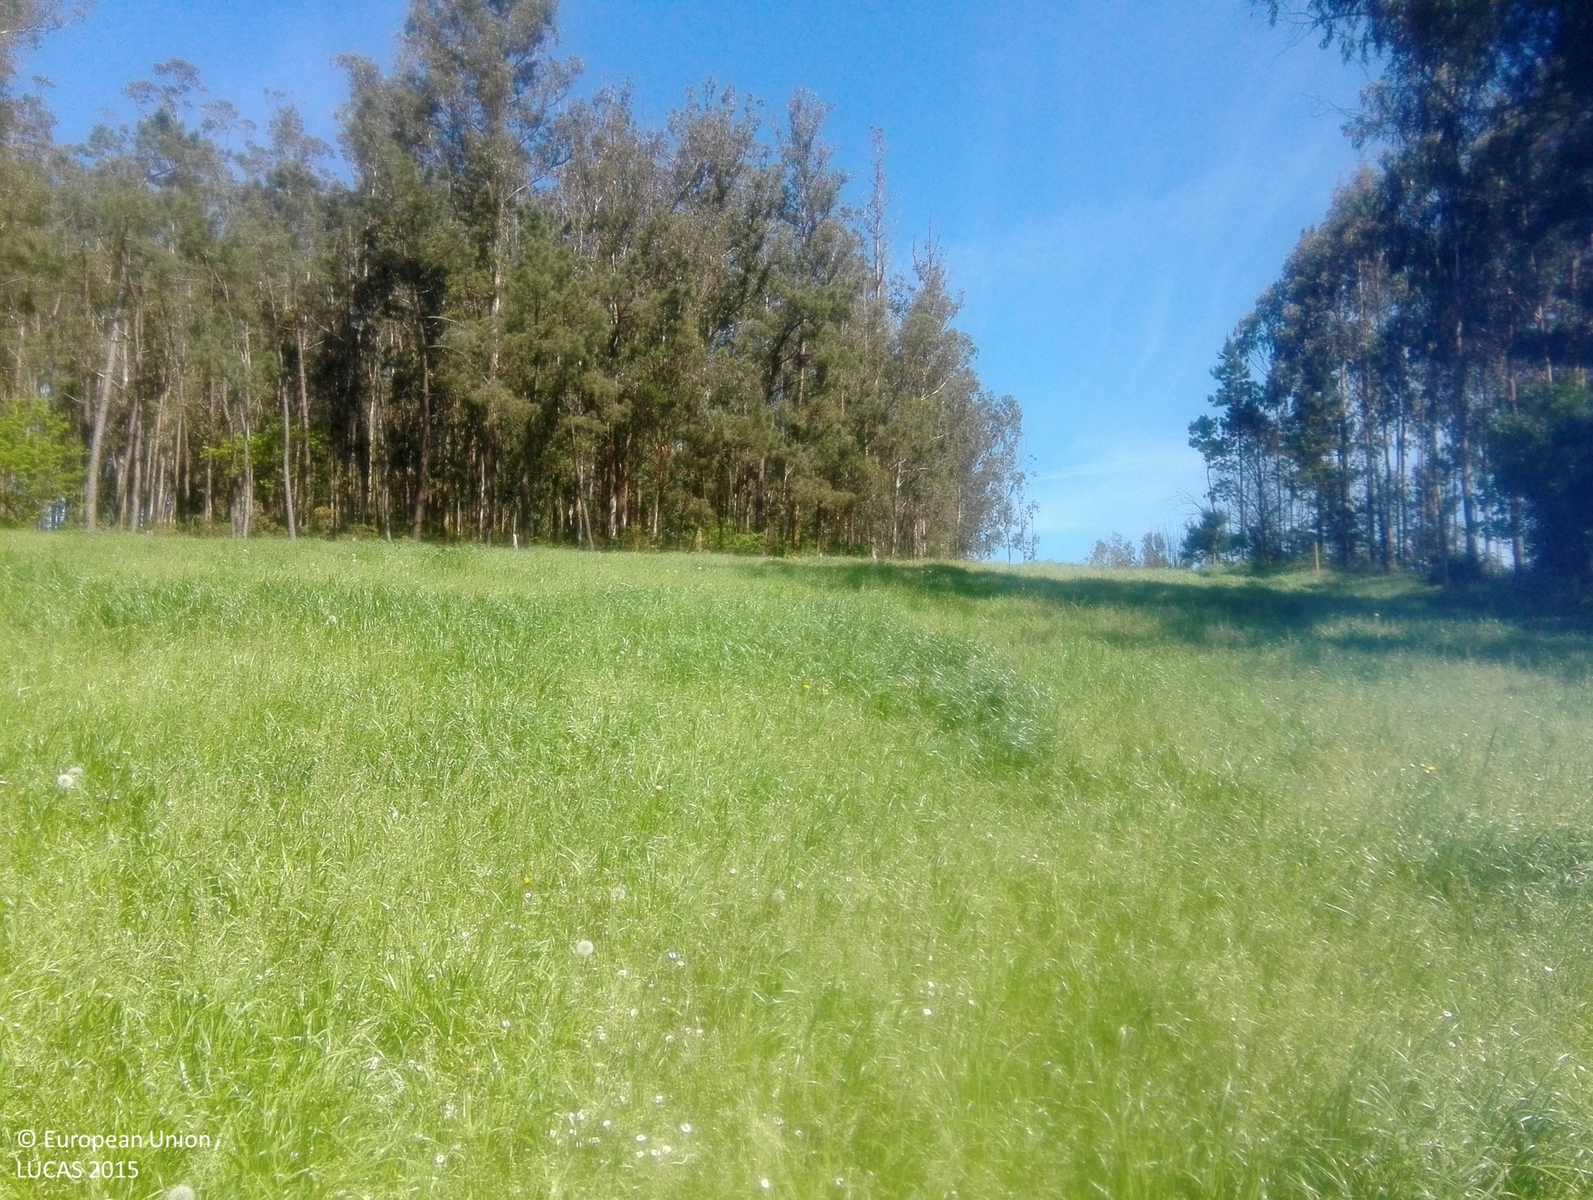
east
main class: Cropland
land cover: Temporary grasslands
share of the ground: > 75 %
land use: Agriculture (excluding fallow land and kitchen gardens)
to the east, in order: Temporary grasslands; Fences; Broadleaved woodland; Tracks; Broadleaved woodland
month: April
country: ES
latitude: 43.4759
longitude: -7.0680
